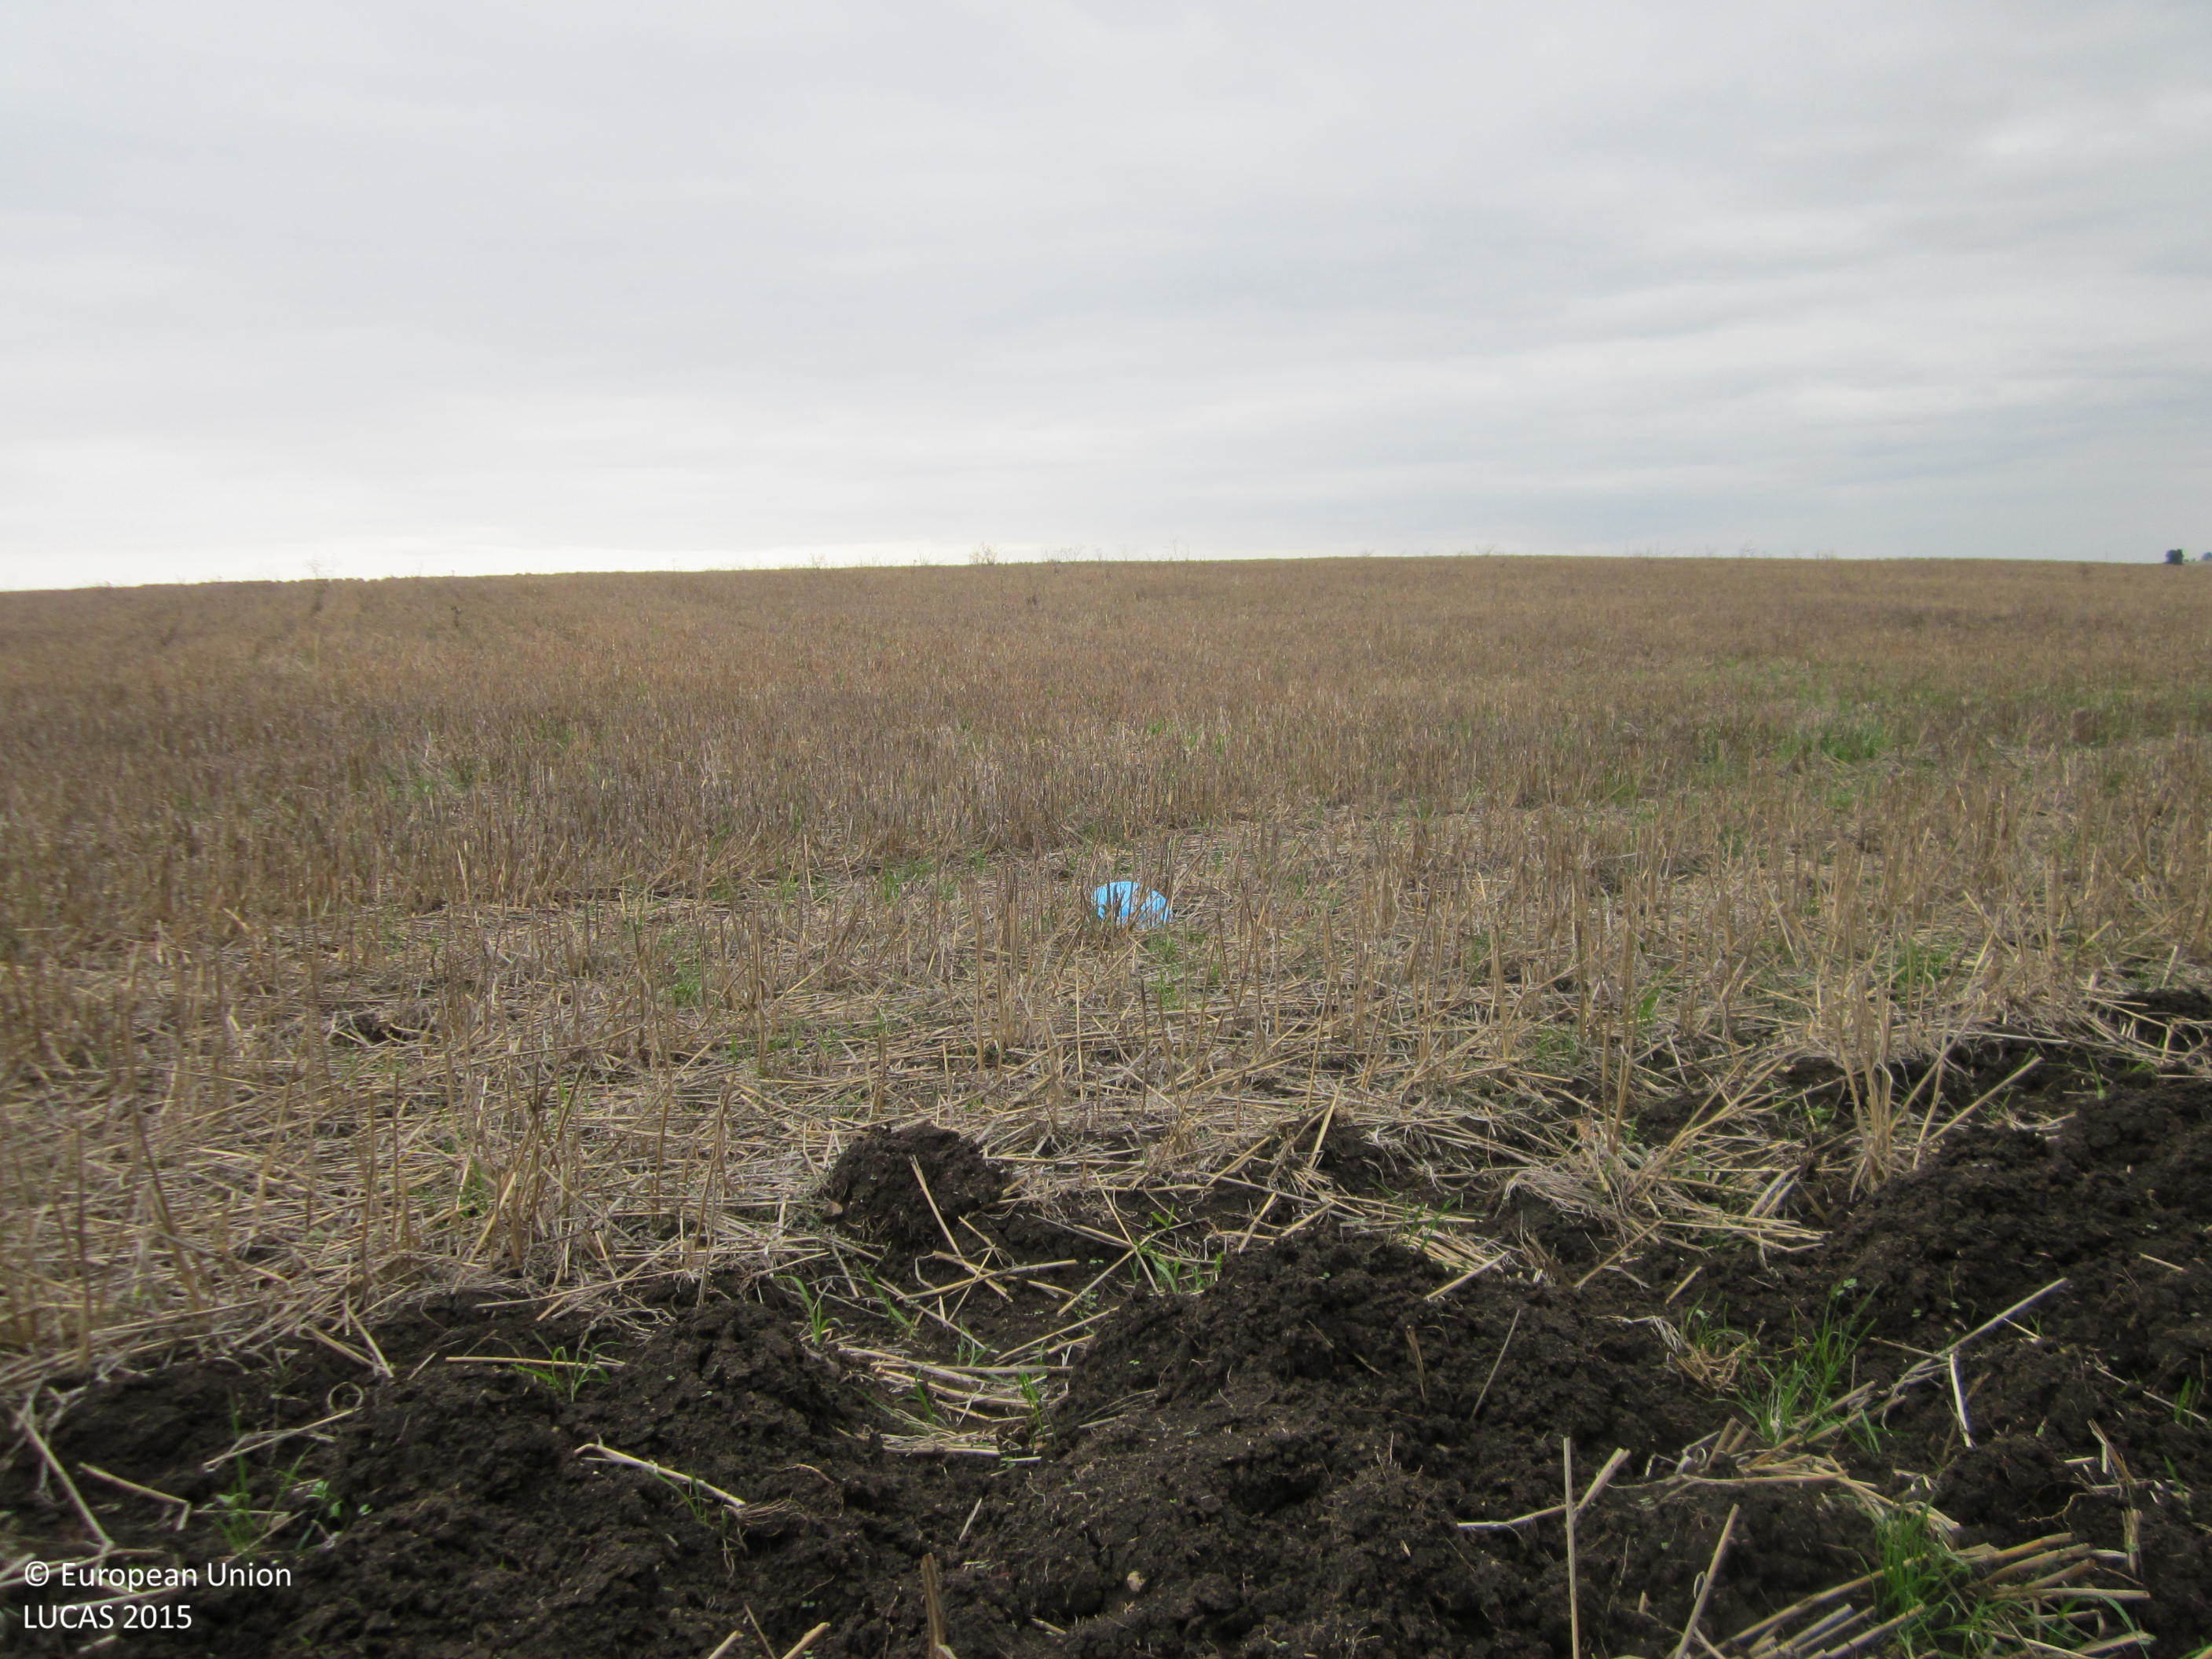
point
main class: Cropland
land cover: Common wheat
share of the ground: 25 - 50 %
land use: Agriculture (excluding fallow land and kitchen gardens)
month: October
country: BG
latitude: 42.3820
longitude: 26.8980
